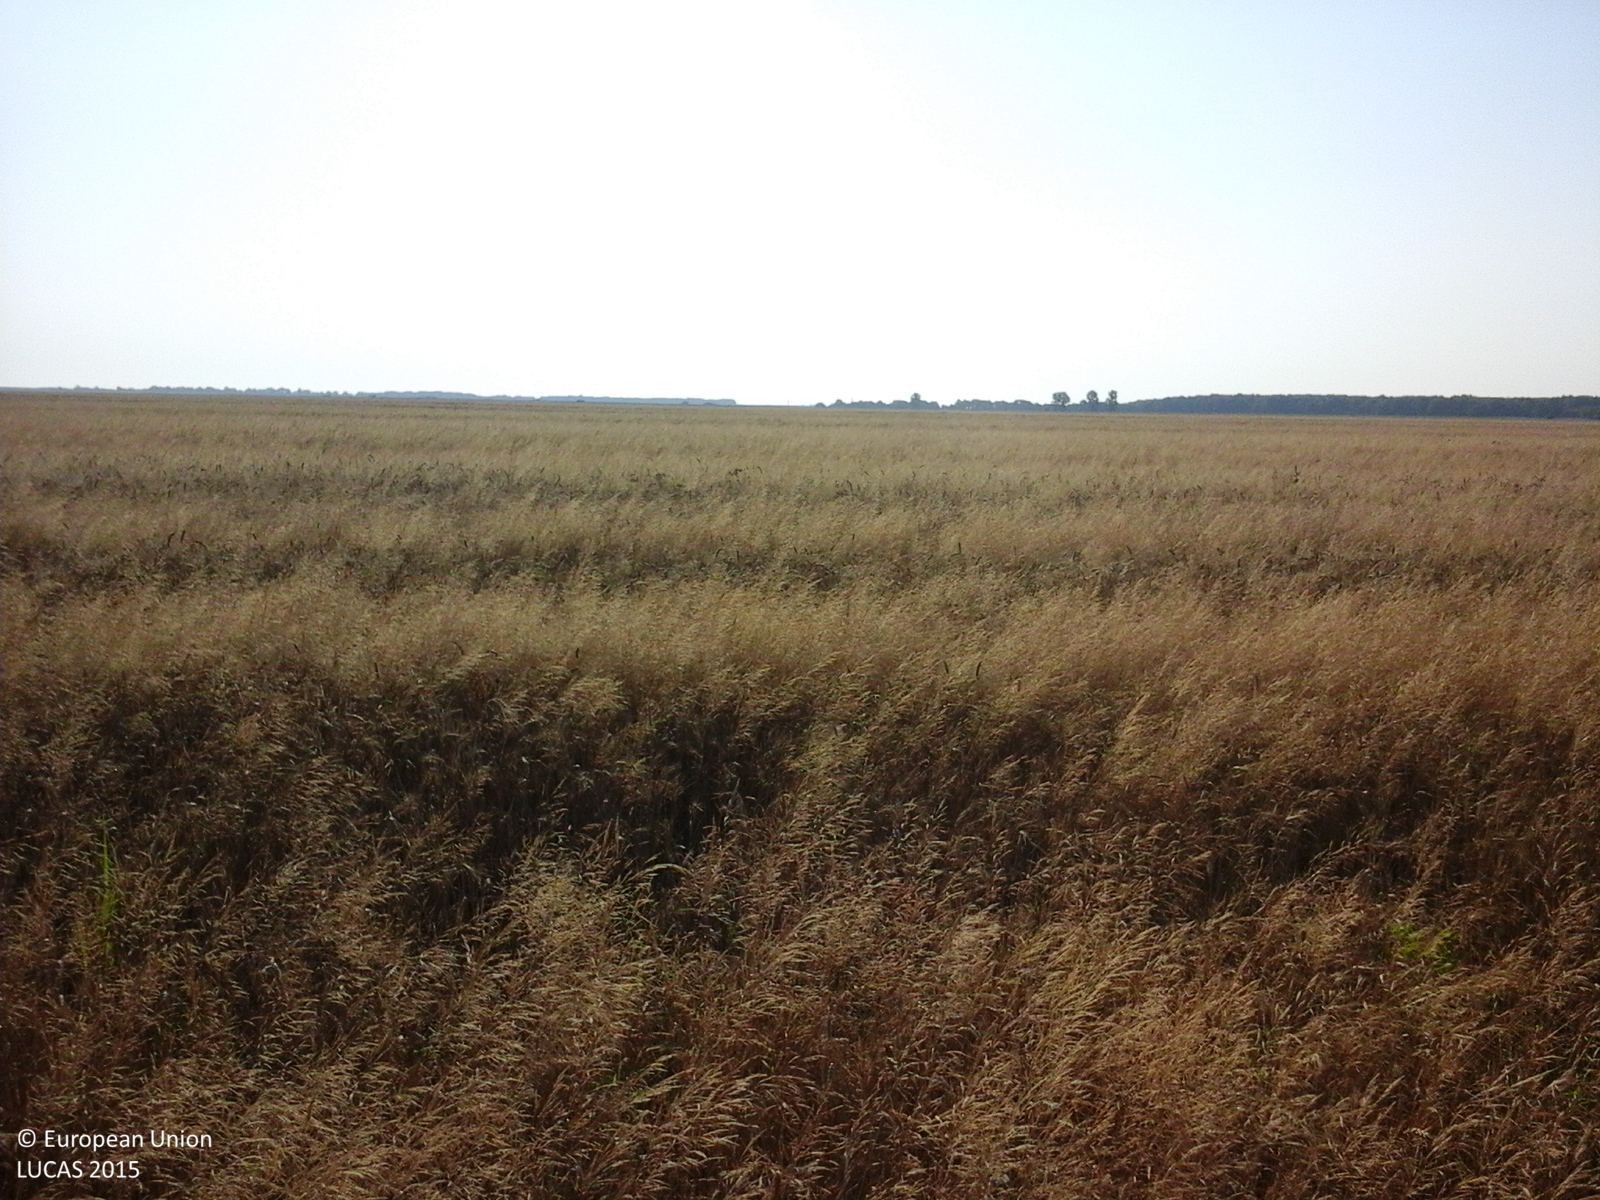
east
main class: Cropland
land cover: Common wheat
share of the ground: > 75 %
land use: Agriculture (excluding fallow land and kitchen gardens)
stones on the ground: < 10 %
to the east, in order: Common wheat
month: July
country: RO
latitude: 44.4796
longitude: 25.0046
